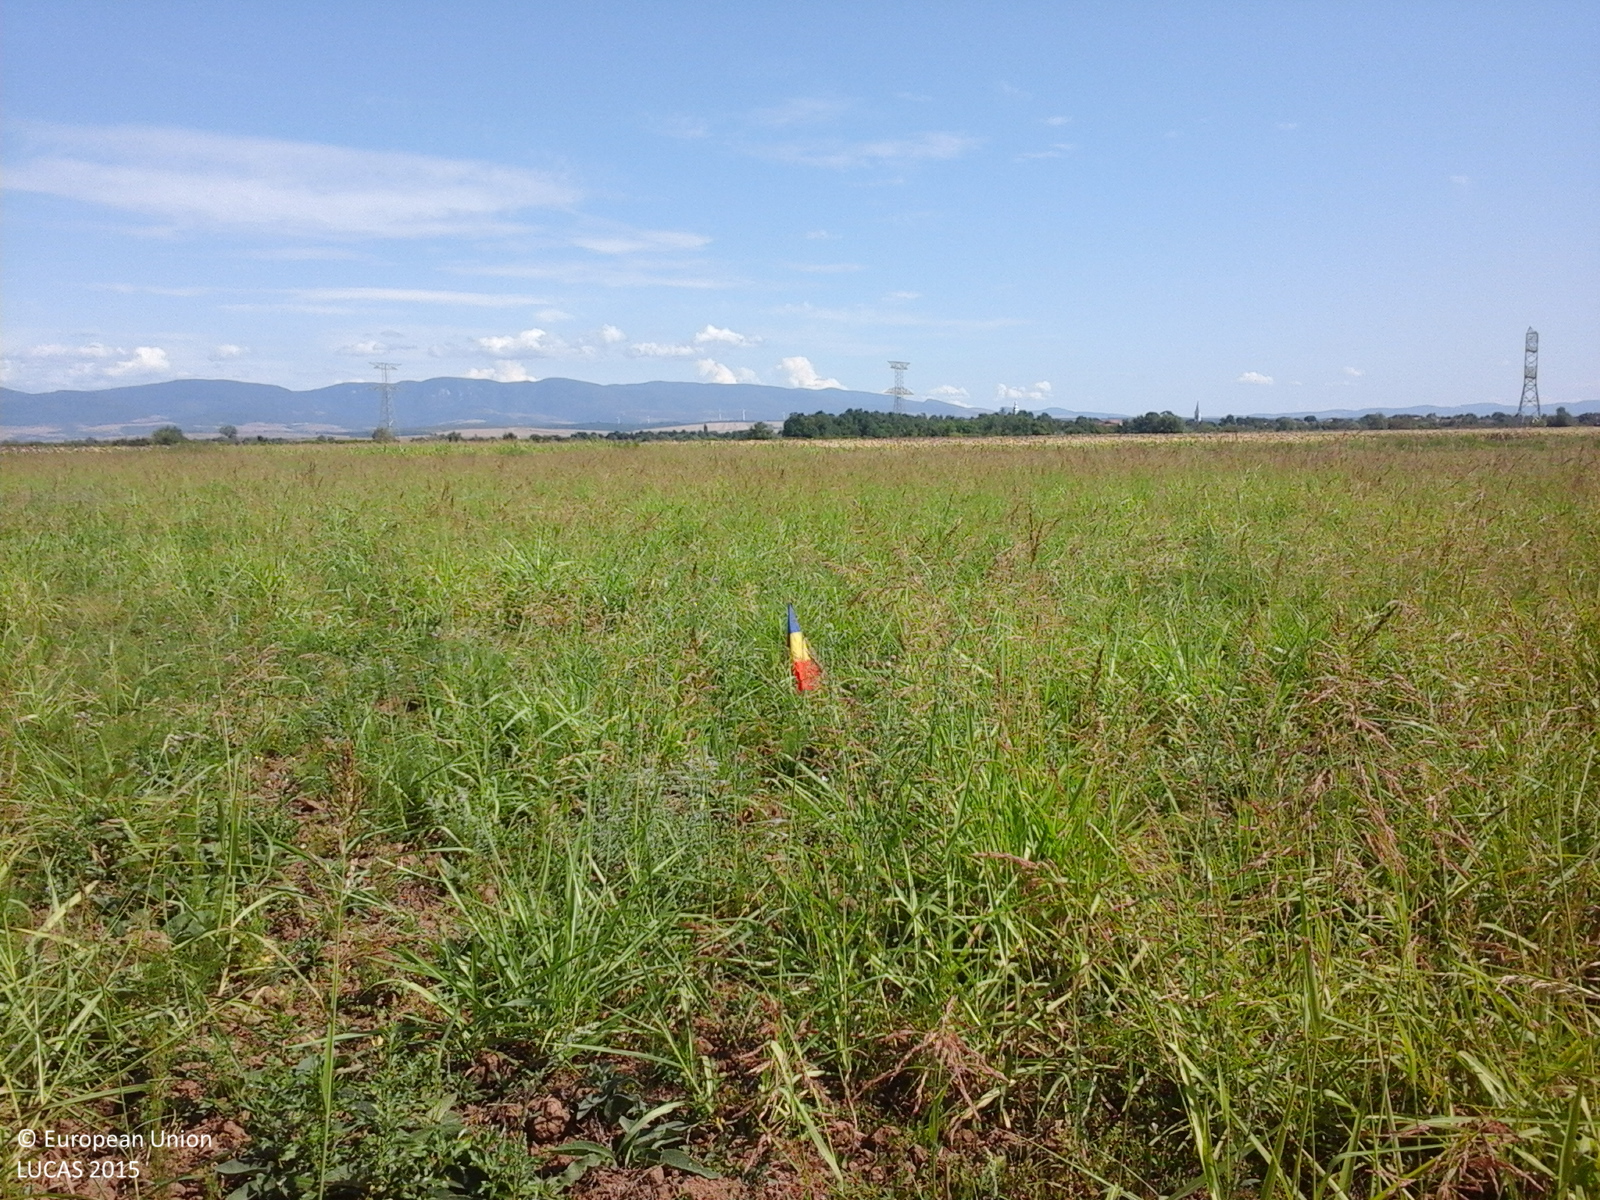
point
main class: Grassland
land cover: Spontaneously vegetated surfaces
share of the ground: > 75 %
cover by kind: herbaceous plants 100 %
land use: Fallow land
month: August
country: RO
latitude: 45.0711
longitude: 21.5249
